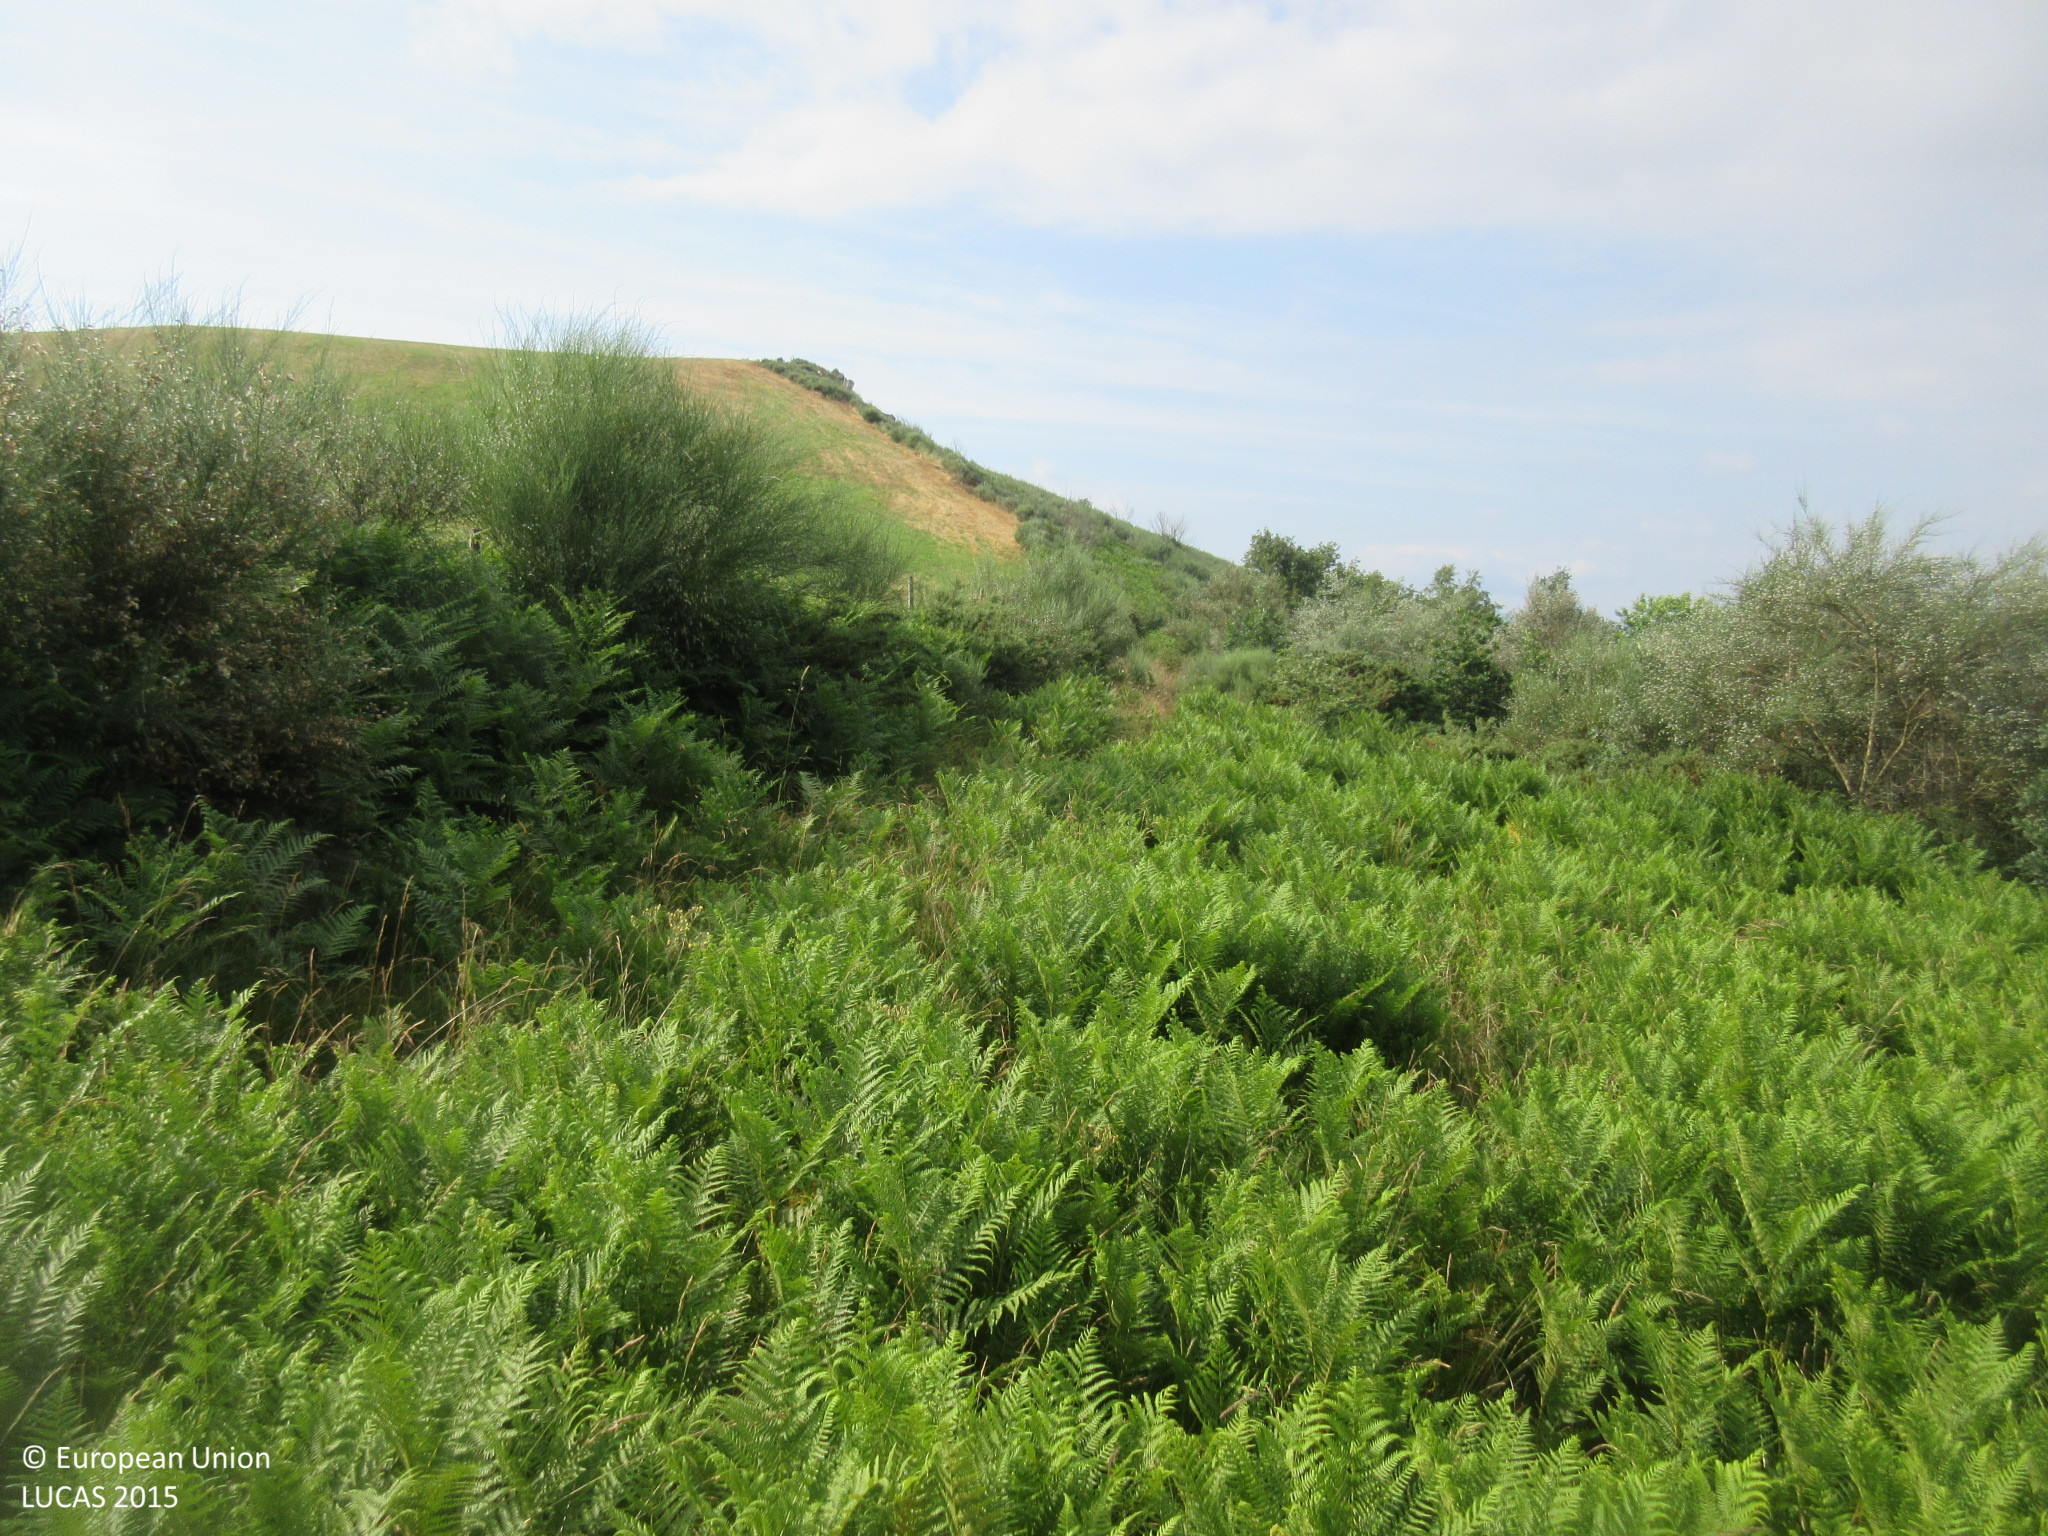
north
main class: Grassland
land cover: Grassland with sparse tree/shrub cover
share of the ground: > 75 %
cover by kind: herbaceous plants 95 %, coniferous forest trees 5 %
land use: Semi-natural and natural areas not in use
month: June
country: ES
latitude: 42.8433
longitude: -7.1073
